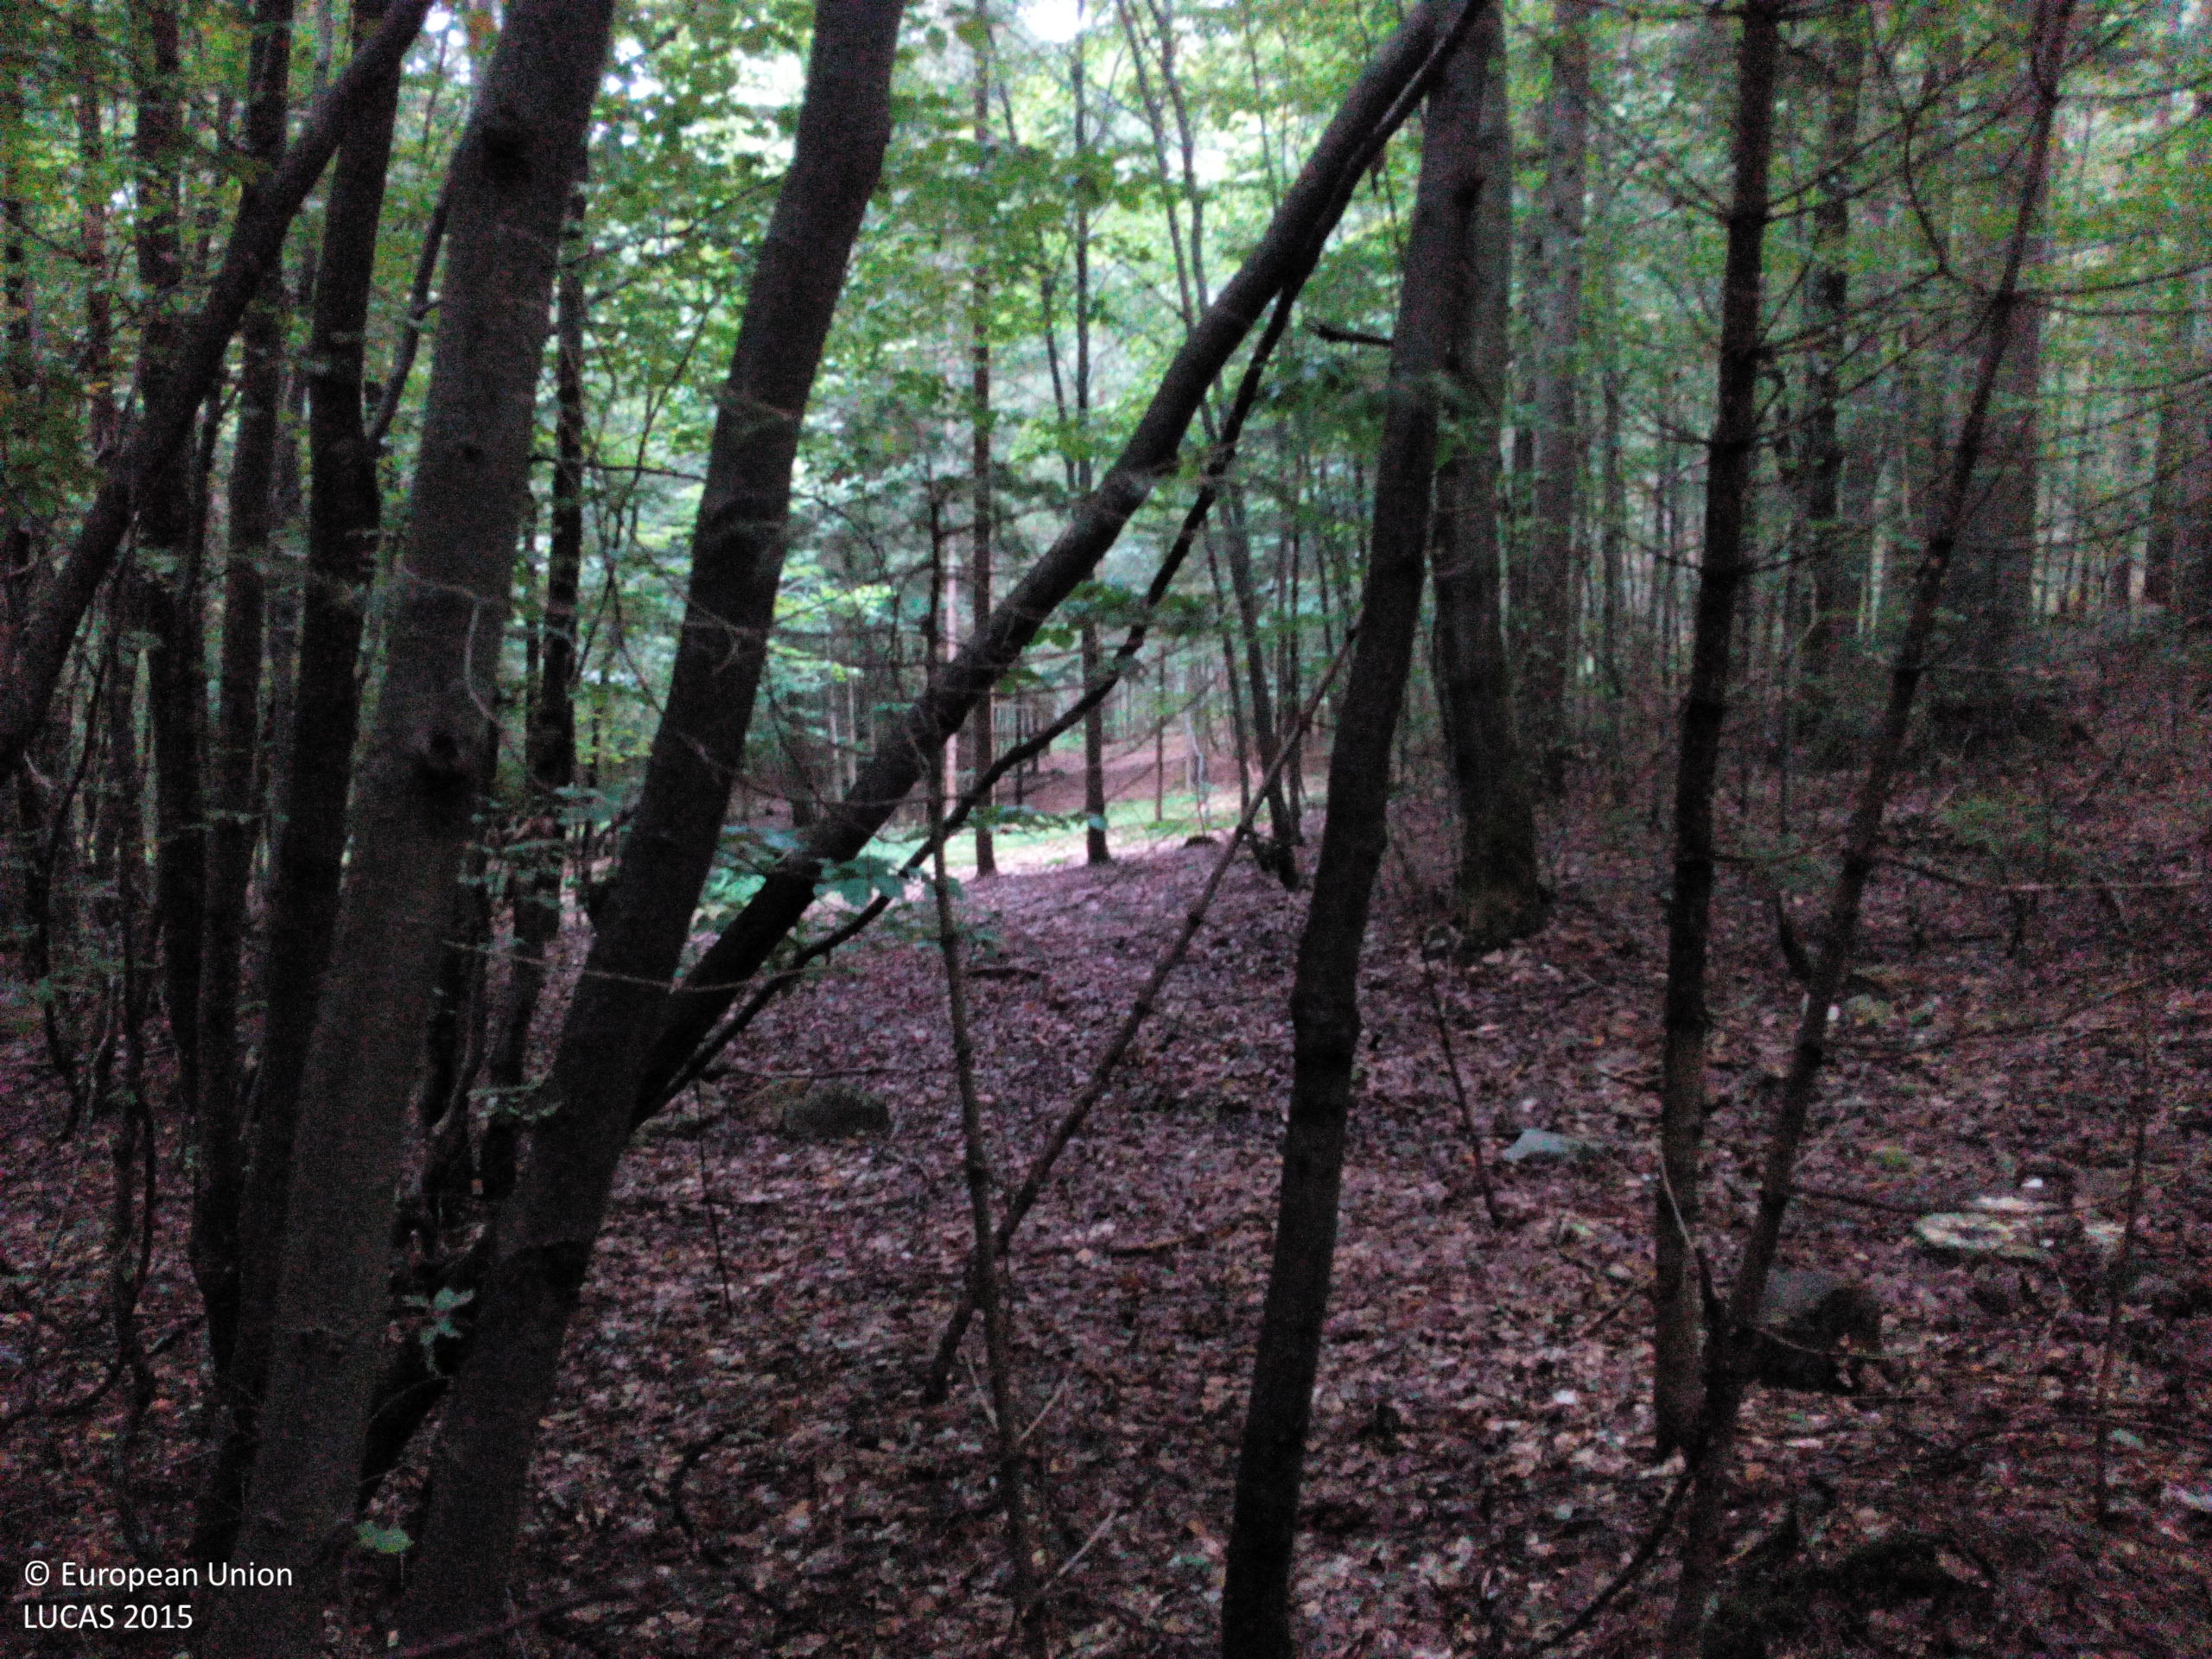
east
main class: Woodland
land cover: Spruce dominated mixed woodland
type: hemiboreal forest and nemoral coniferous forest and mixed broadleaved-coniferous forest
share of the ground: > 75 %
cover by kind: broadleaved forest trees 55 %, coniferous forest trees 40 %, unconsolidated bare surface 5 %
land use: Forestry
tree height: > 5 m
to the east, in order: Spruce dominated mixed woodland; Tracks; Spruce dominated mixed woodland; Tracks; Spruce dominated mixed woodland; Spruce dominated coniferous woodland; Rivers and streams; Spruce dominated coniferous woodland
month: September
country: DE
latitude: 48.9675
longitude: 13.2644
